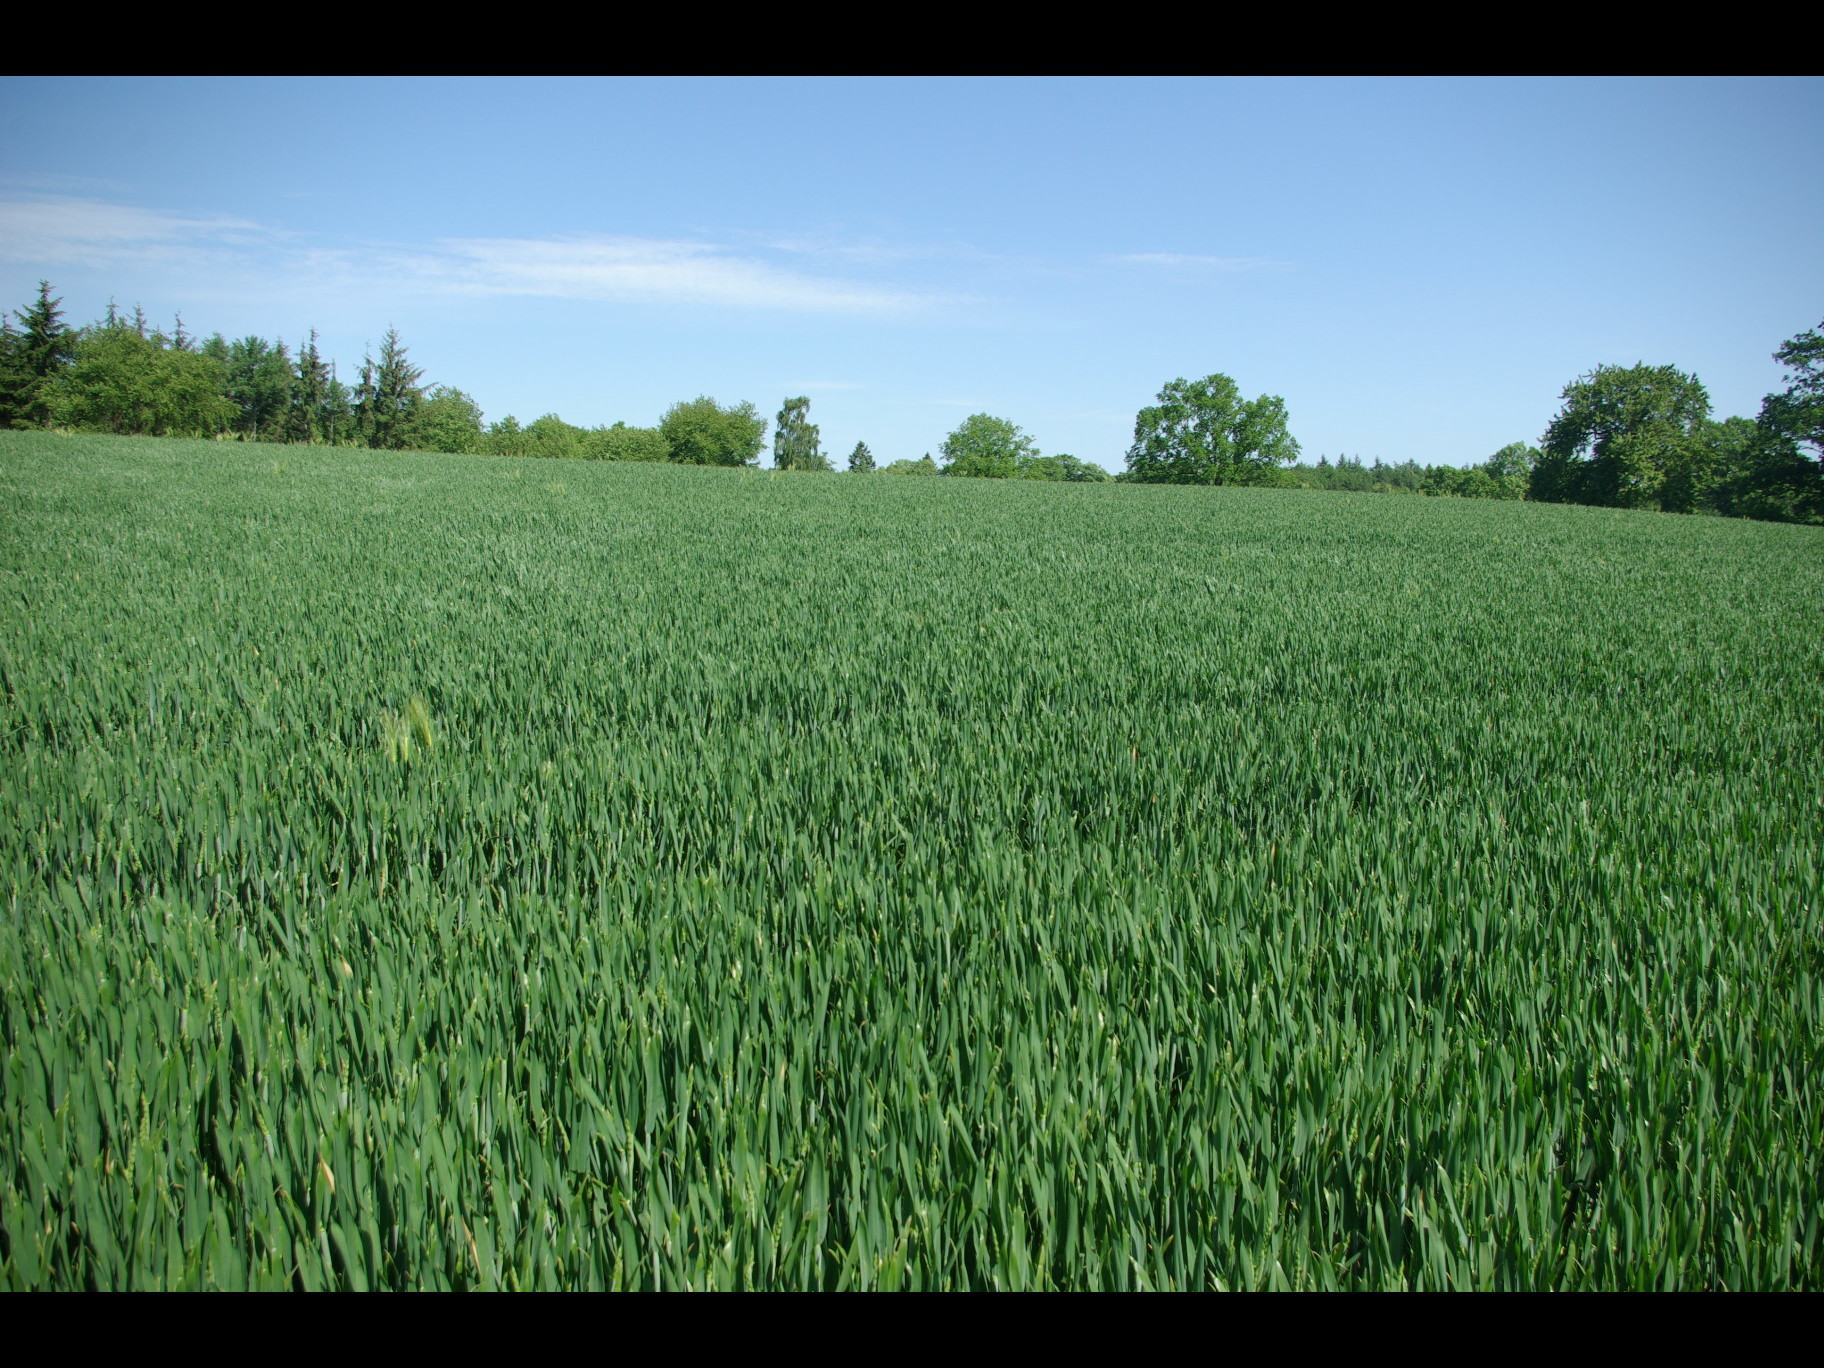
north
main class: Cropland
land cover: Common wheat
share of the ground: > 75 %
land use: Agriculture (excluding fallow land and kitchen gardens)
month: June
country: DE
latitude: 54.1911
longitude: 10.6280
